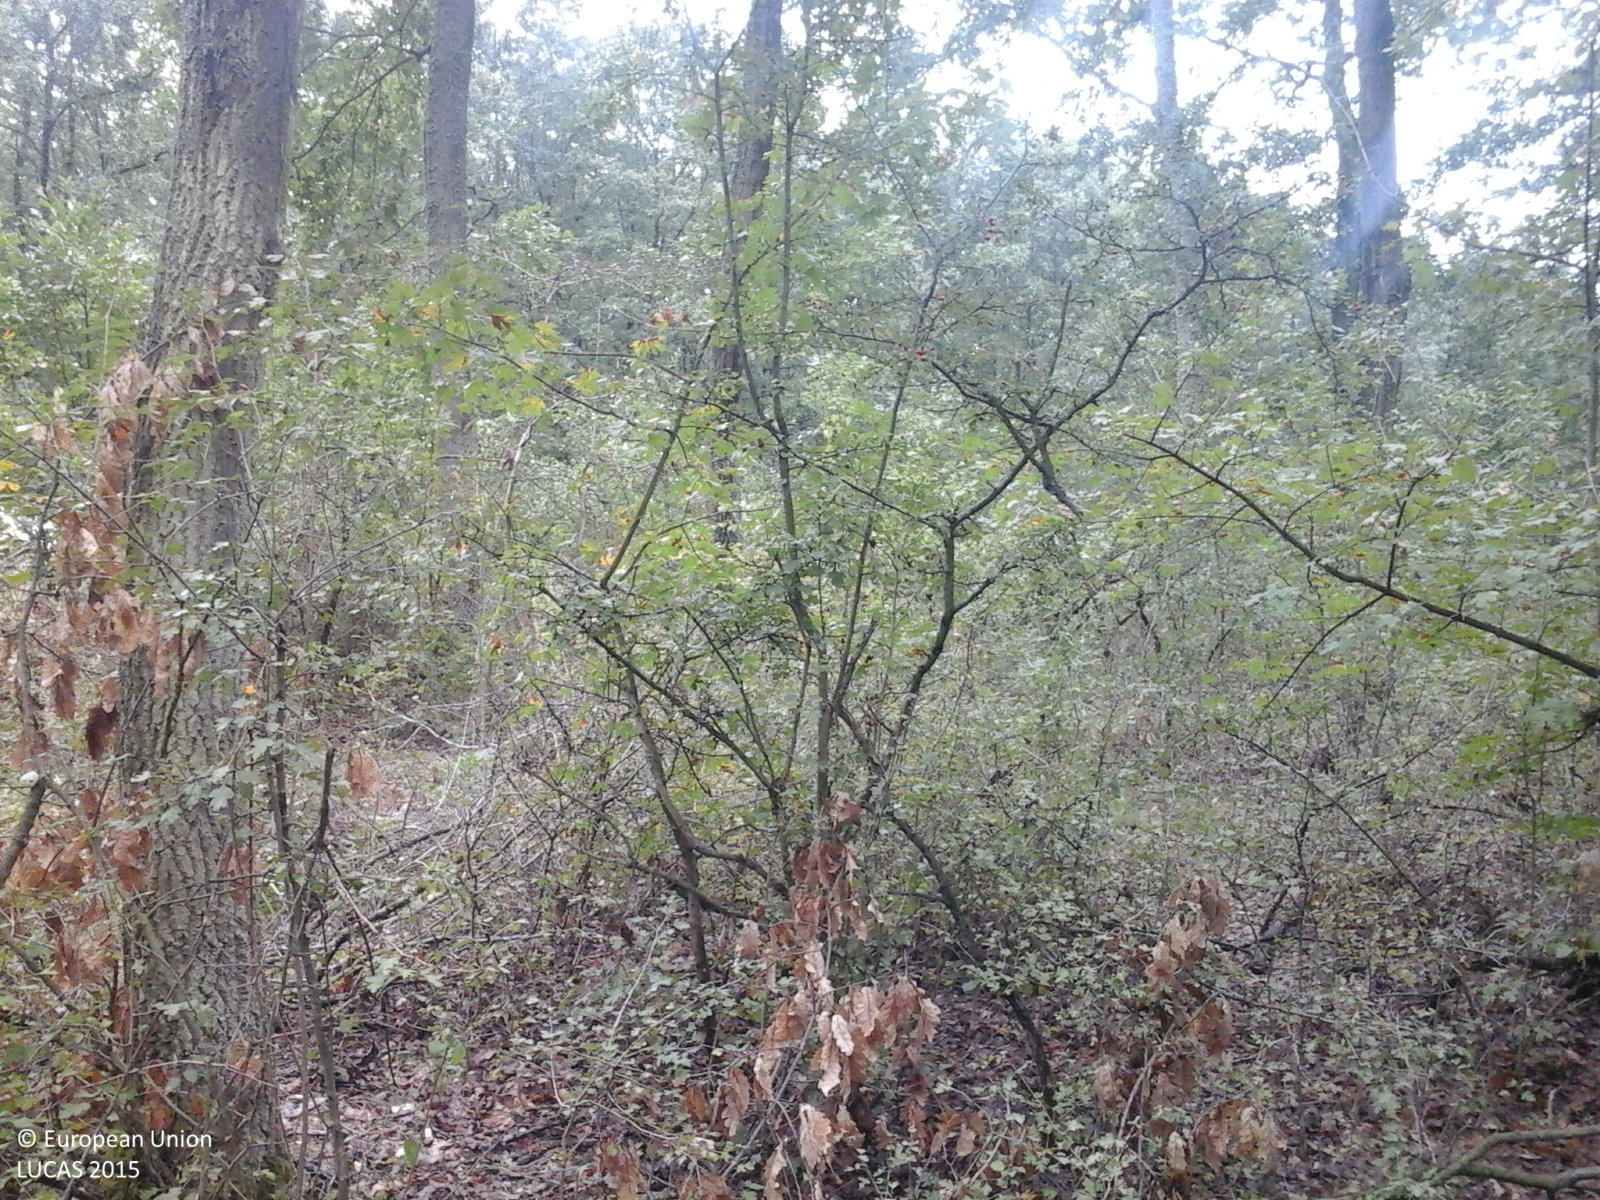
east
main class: Woodland
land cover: Broadleaved woodland
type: acidophilous oak and oak-birch forest
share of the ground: > 75 %
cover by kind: broadleaved forest trees 80 %, shrubs 10 %, herbaceous plants 10 %
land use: Forestry
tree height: > 5 m
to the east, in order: Broadleaved woodland; Grassland without tree/shrub cover; Tracks; Broadleaved woodland
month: September
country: RO
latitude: 46.8027
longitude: 21.8232
